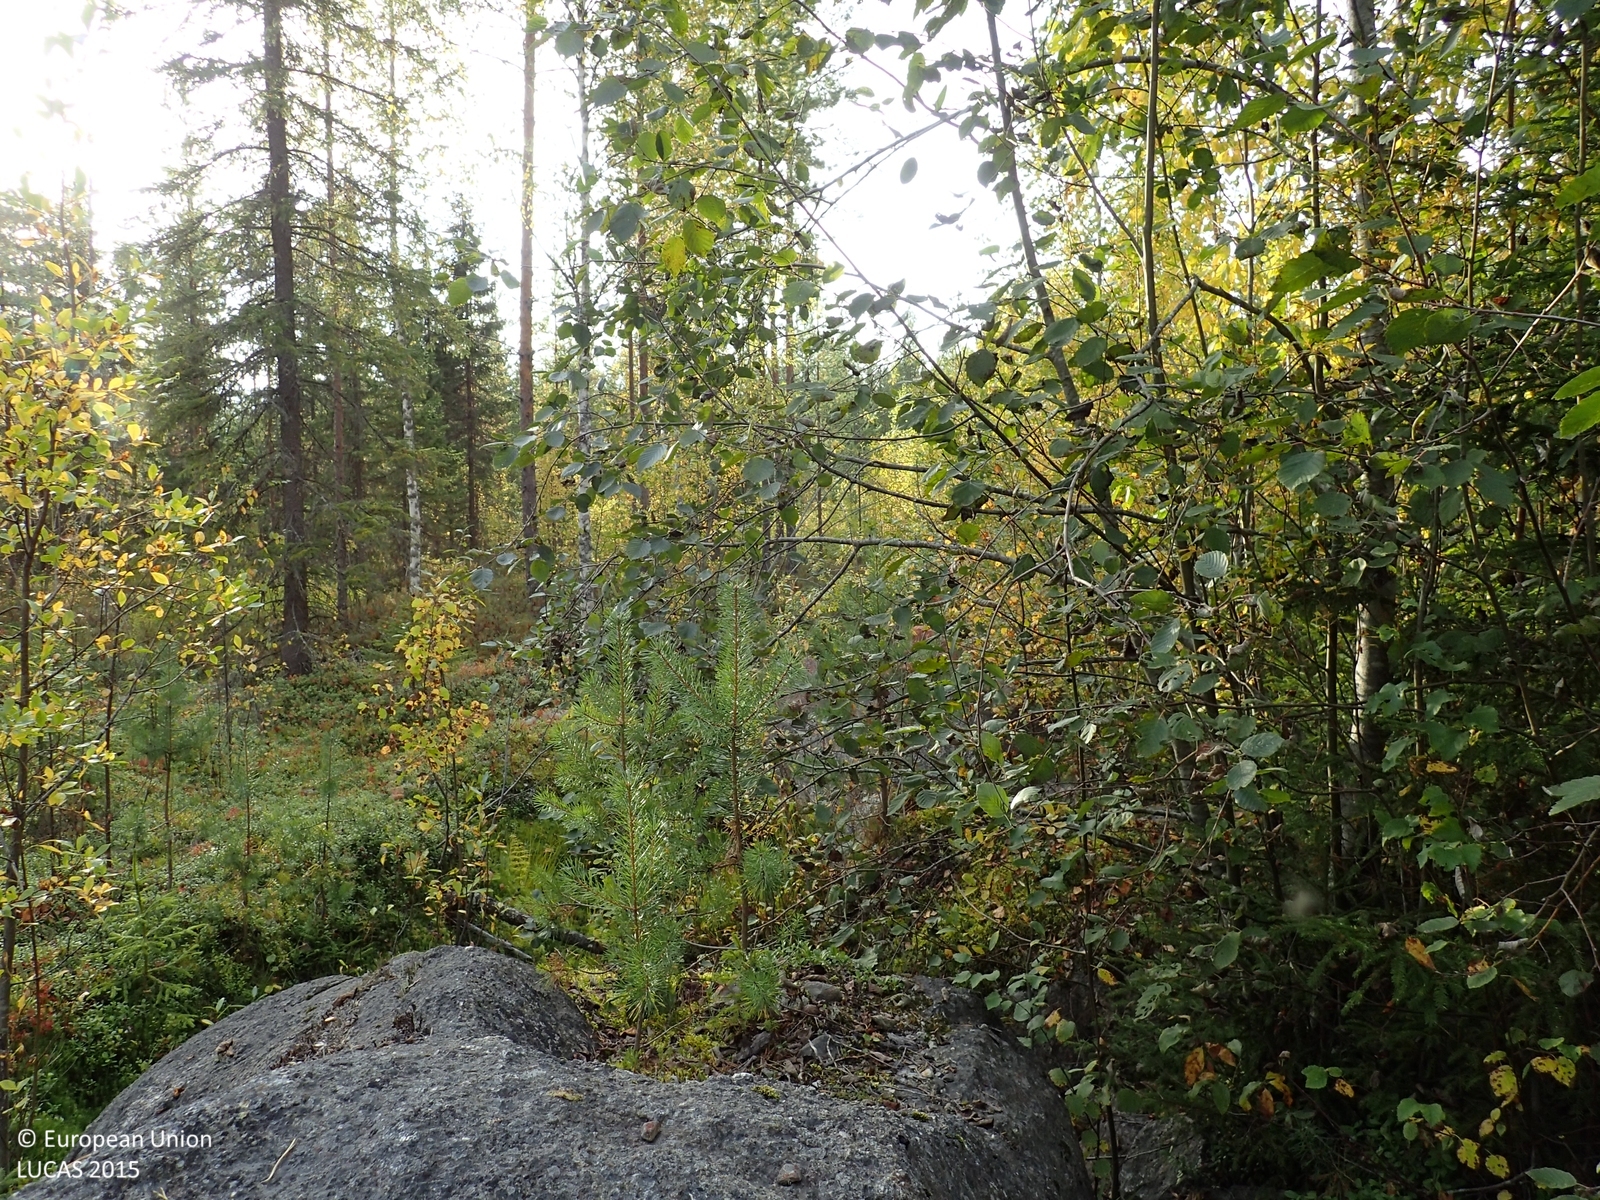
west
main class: Woodland
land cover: Pine dominated mixed woodland
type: boreal forest
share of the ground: 50 - 75 %
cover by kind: shrubs 40 %, broadleaved forest trees 35 %, coniferous forest trees 15 %, lichens and mosses 5 %, consolidated bare surface 5 %
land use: Forestry
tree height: < 5 m
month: September
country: FI
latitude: 63.0316
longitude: 25.7464
